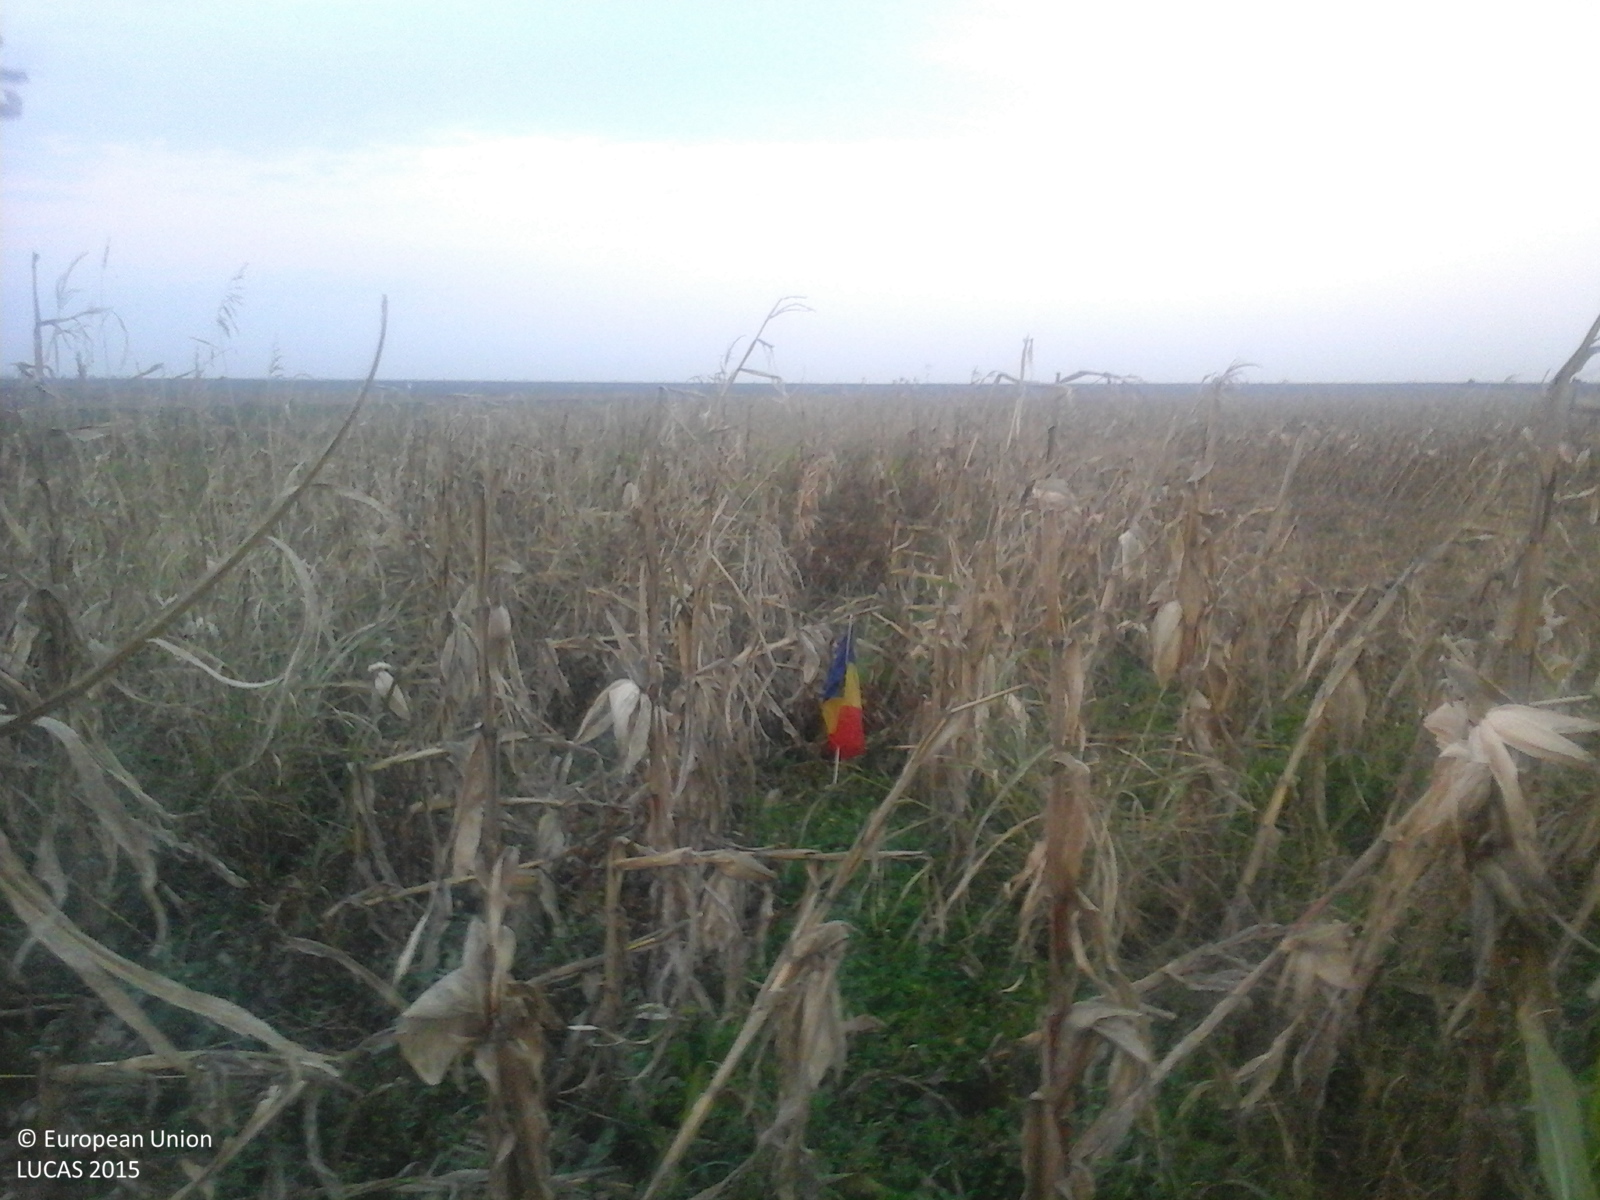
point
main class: Cropland
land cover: Maize
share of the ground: > 75 %
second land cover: Spontaneously vegetated surfaces
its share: 25 - 50 %
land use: Agriculture (excluding fallow land and kitchen gardens)
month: October
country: RO
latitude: 45.2677
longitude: 27.0251
